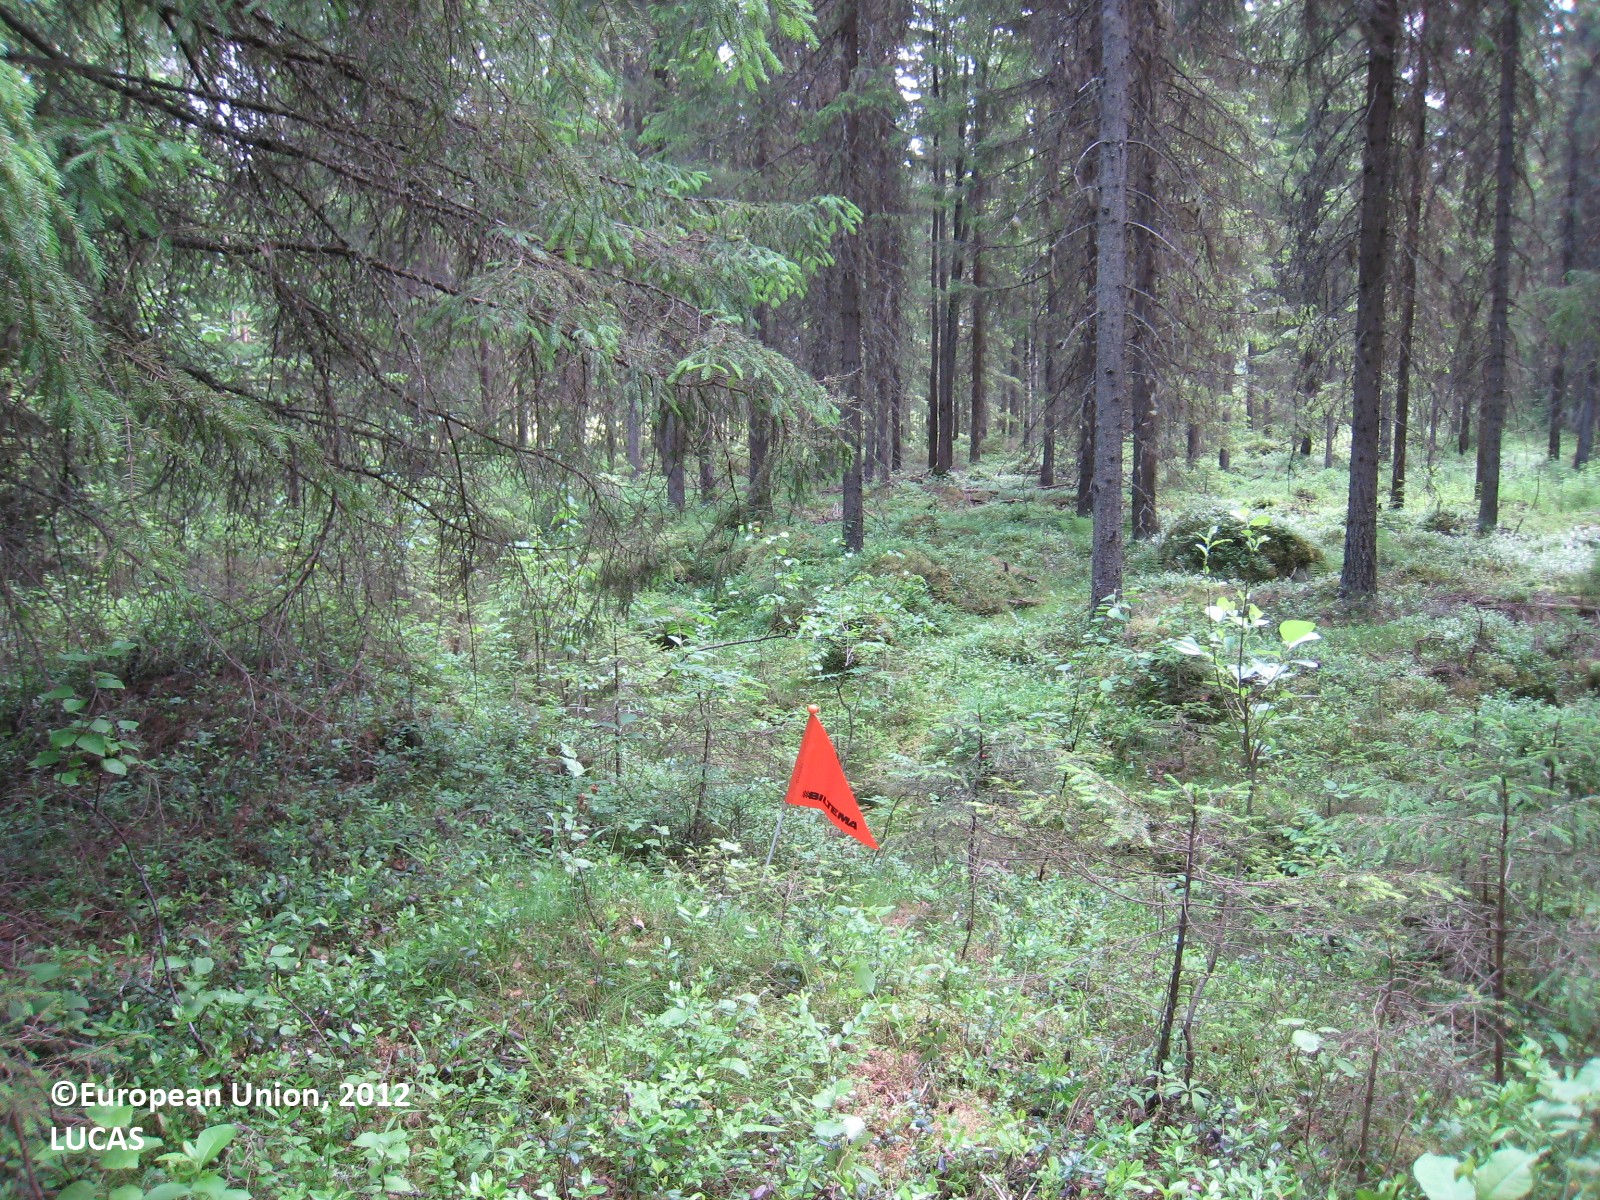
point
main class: Woodland
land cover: Spruce dominated coniferous woodland
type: boreal forest
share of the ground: 50 - 75 %
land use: Forestry
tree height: > 5 m
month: July
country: FI
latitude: 63.1970
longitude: 25.7545
